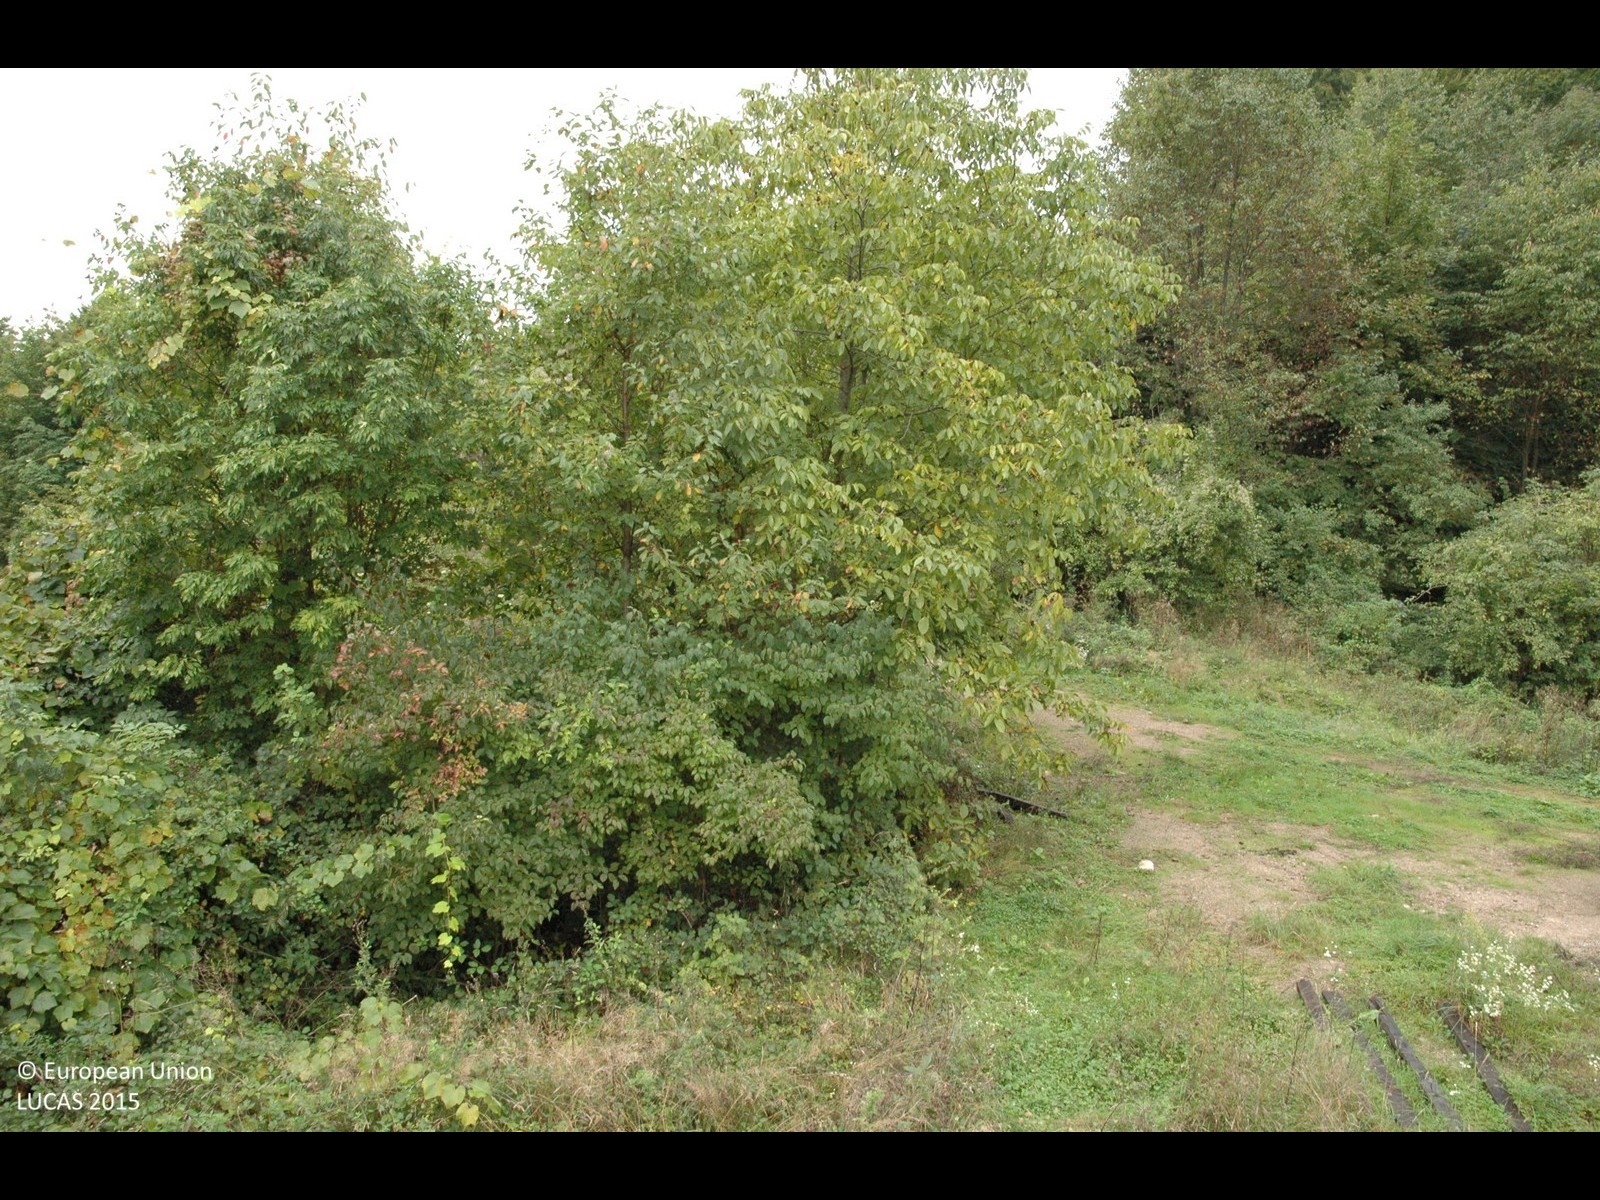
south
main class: Shrubland
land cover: Shrubland with sparse tree cover
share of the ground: > 75 %
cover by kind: shrubs 95 %, broadleaved forest trees 5 %
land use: Semi-natural and natural areas not in use
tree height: > 5 m
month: September
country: HR
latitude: 45.0103
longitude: 15.6412
